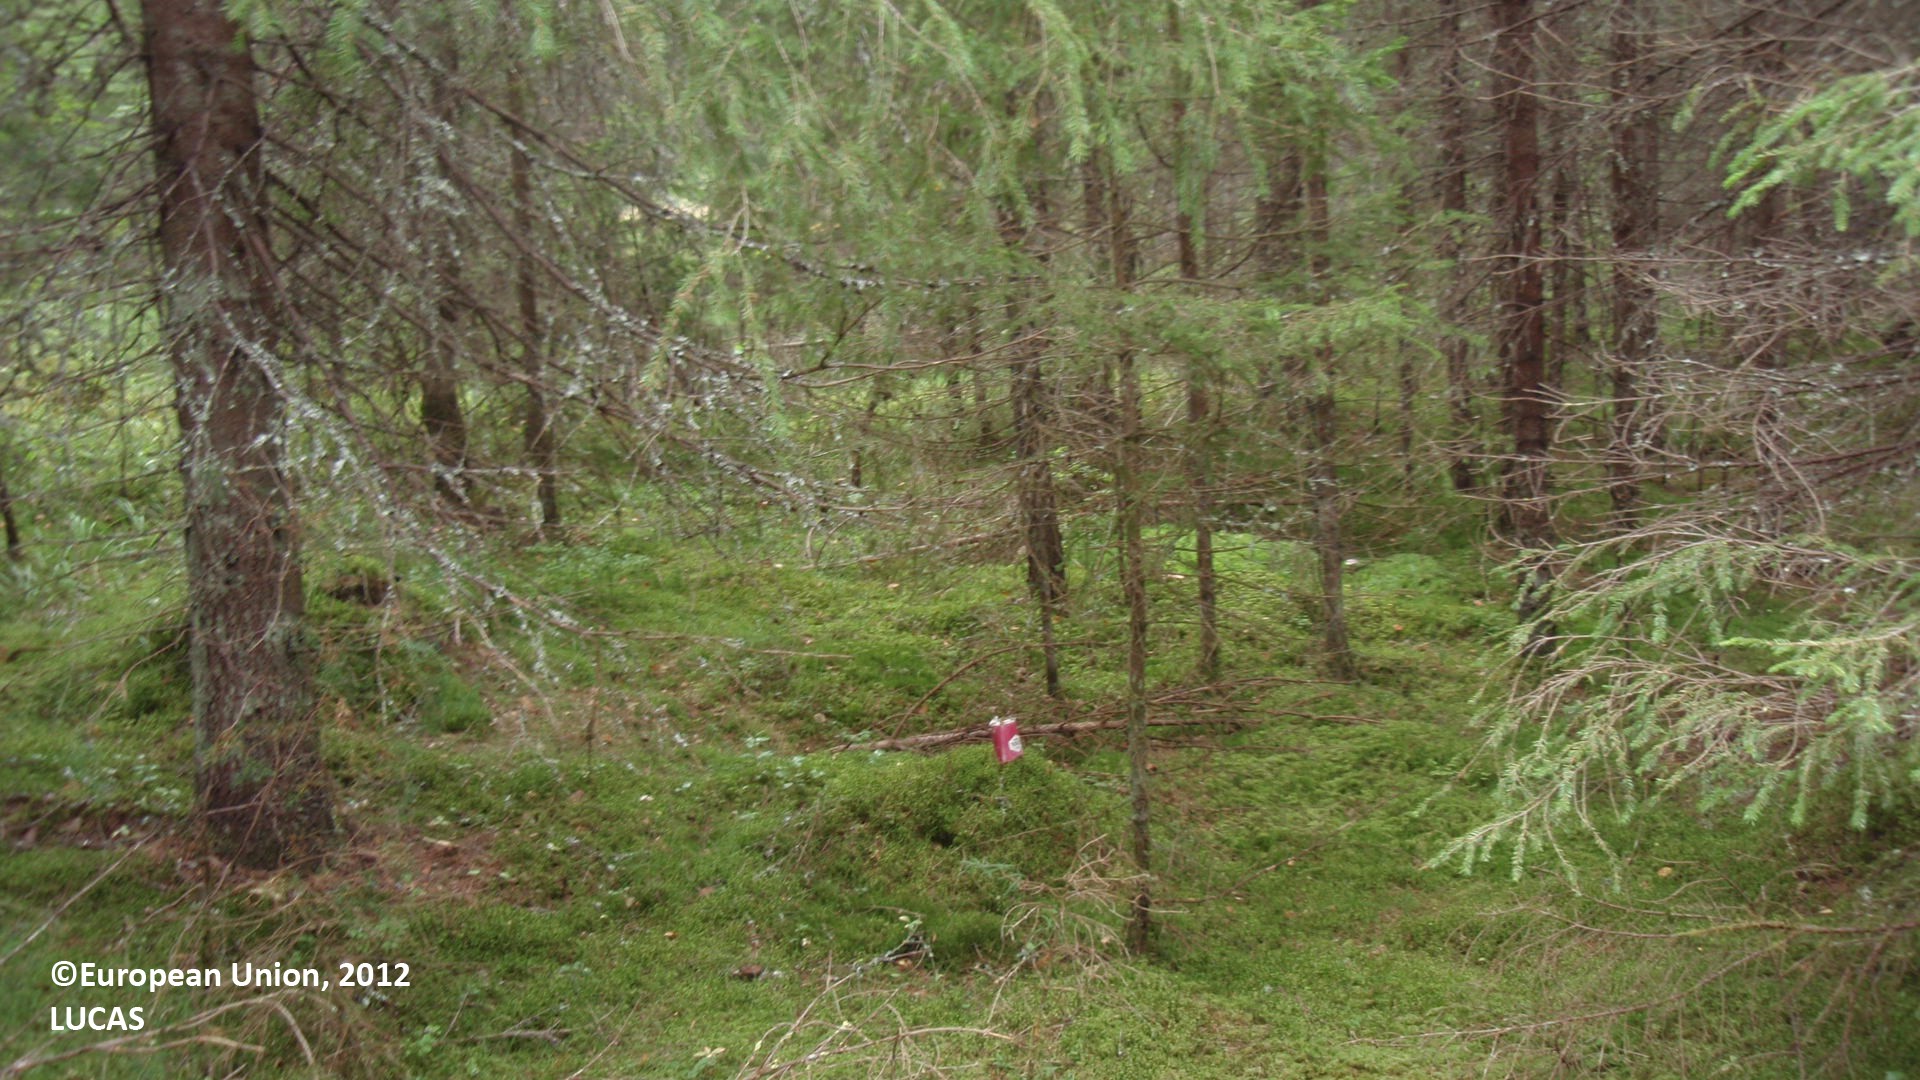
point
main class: Woodland
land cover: Spruce dominated coniferous woodland
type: boreal forest
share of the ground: 50 - 75 %
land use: Forestry
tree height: > 5 m
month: August
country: FI
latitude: 60.8160
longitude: 27.3313
